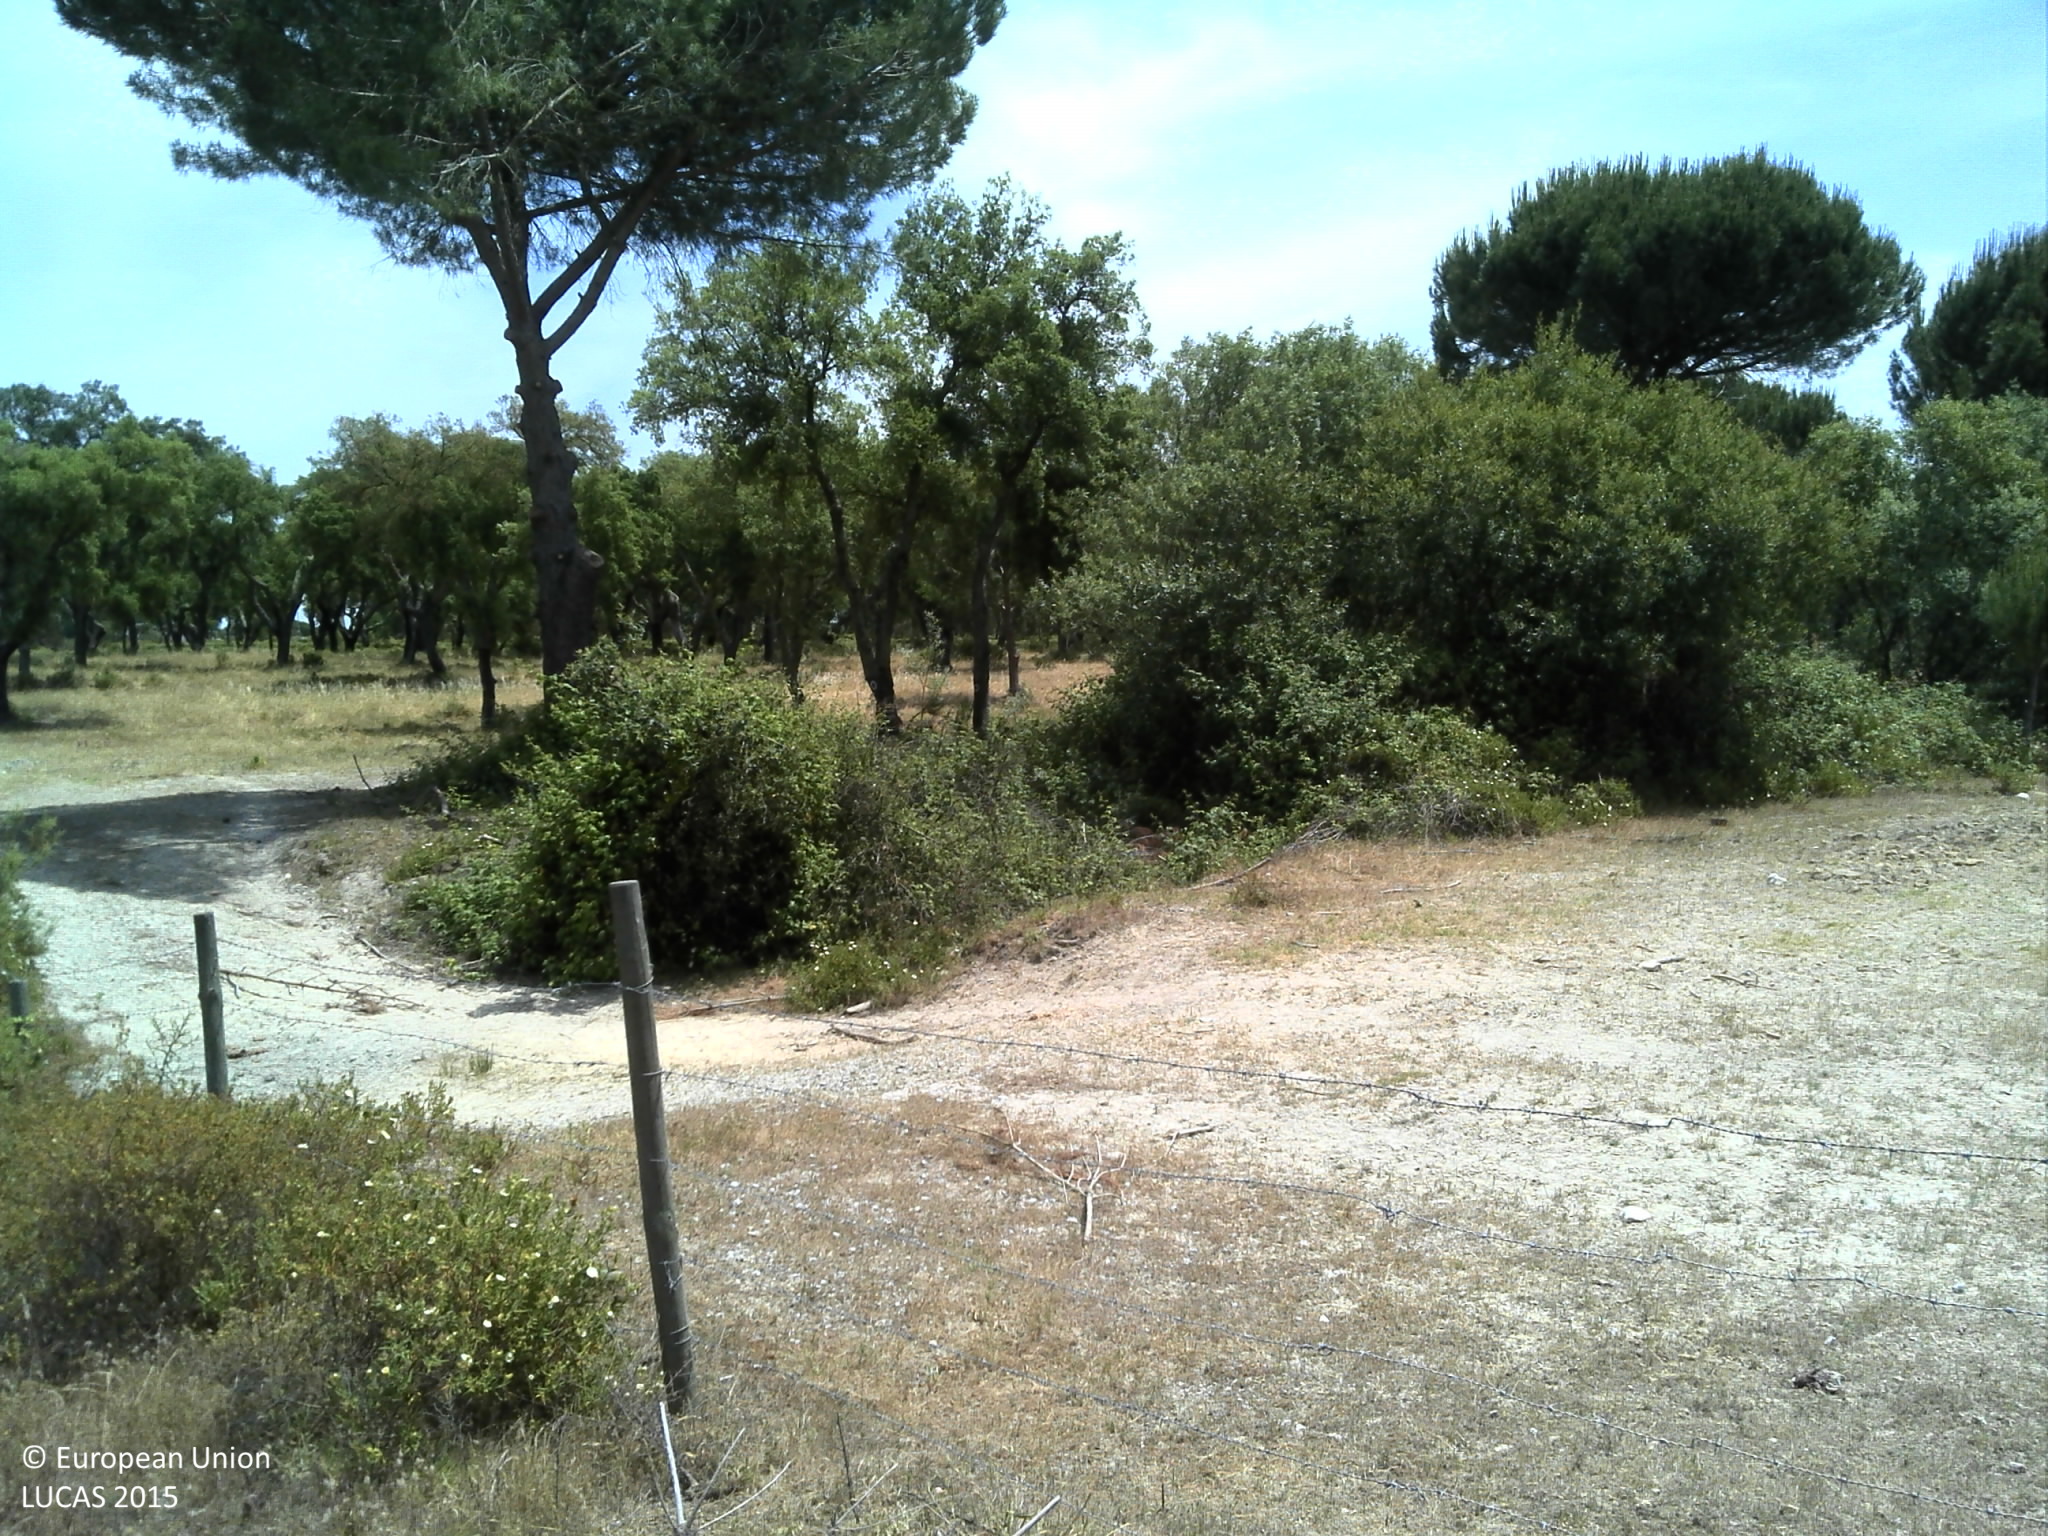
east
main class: Woodland
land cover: Pine dominated mixed woodland
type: coniferous forest of the mediterranean region
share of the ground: 10 - 25 %
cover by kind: herbaceous plants 40 %, coniferous forest trees 30 %, broadleaved forest trees 25 %, unconsolidated bare surface 5 %
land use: Forestry
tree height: > 5 m
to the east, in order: Pine dominated mixed woodland; Tracks; Pine dominated coniferous woodland; Pine dominated mixed woodland
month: May
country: PT
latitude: 38.6045
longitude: -8.5793
